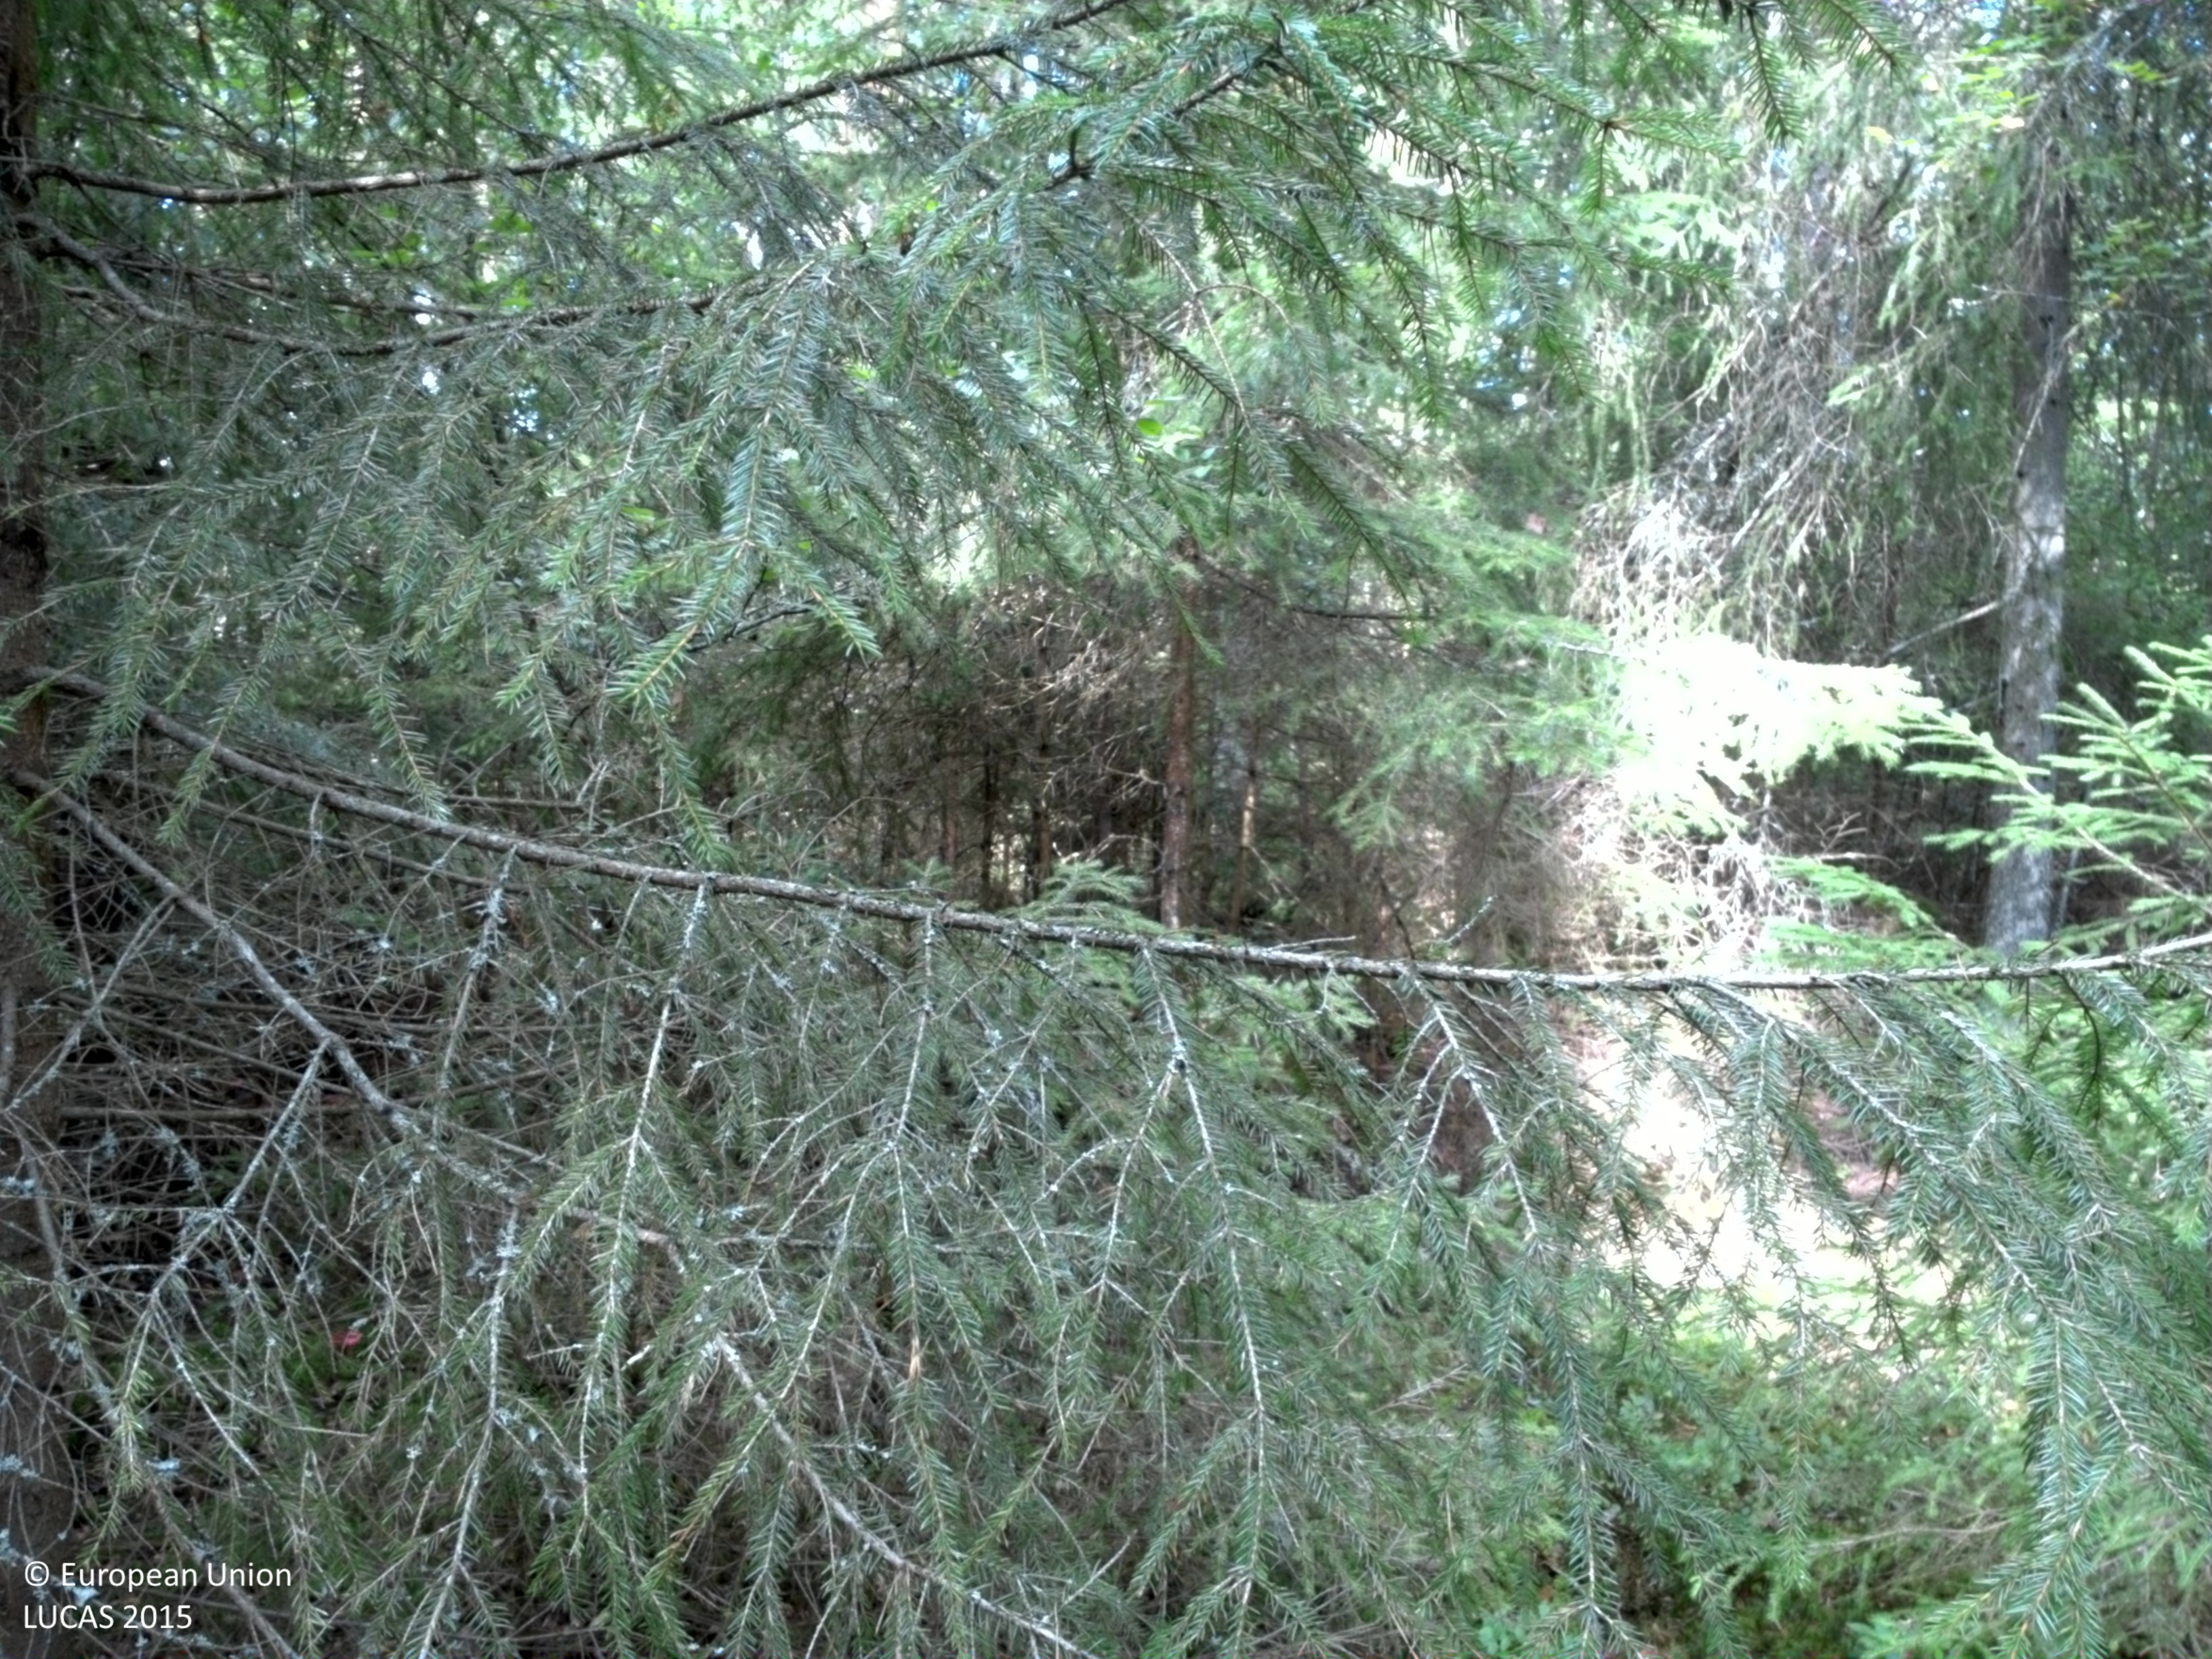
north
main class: Woodland
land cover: Other coniferous woodland
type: boreal forest
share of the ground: > 75 %
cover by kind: coniferous forest trees 75 %, shrubs 10 %, lichens and mosses 10 %, broadleaved forest trees 5 %
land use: Forestry
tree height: > 5 m
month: August
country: SE
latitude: 59.9850
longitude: 16.3168
